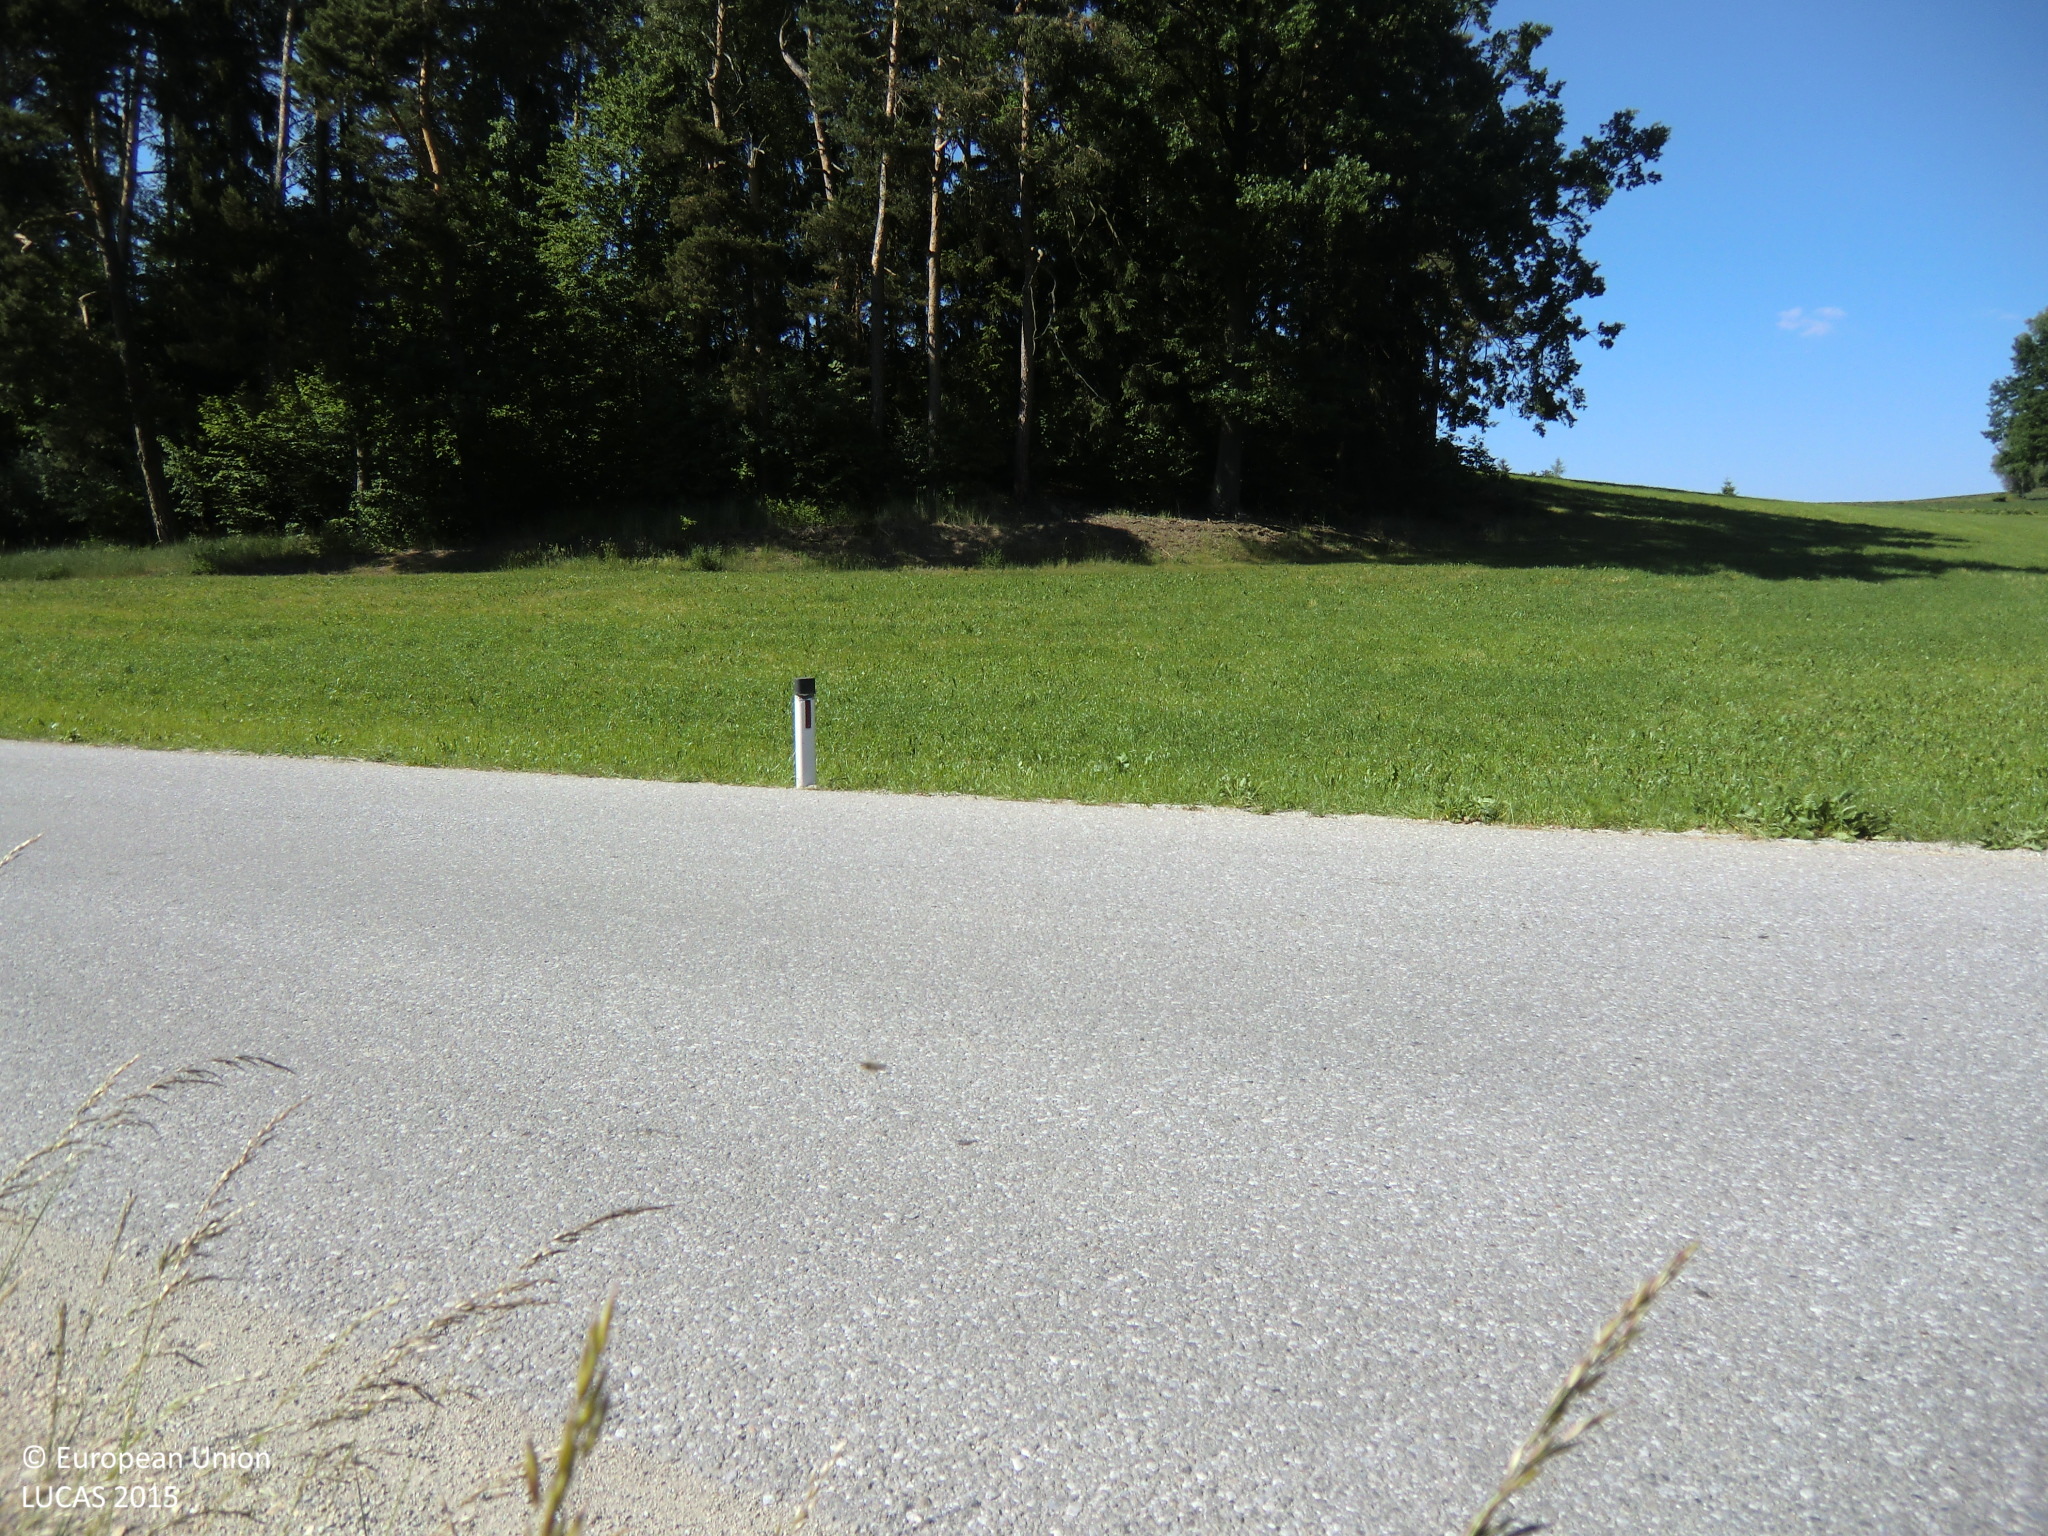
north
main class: Grassland
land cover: Grassland without tree/shrub cover
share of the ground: > 75 %
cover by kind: herbaceous plants 100 %
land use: Agriculture (excluding fallow land and kitchen gardens)
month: June
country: AT
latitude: 48.6480
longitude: 15.0648
